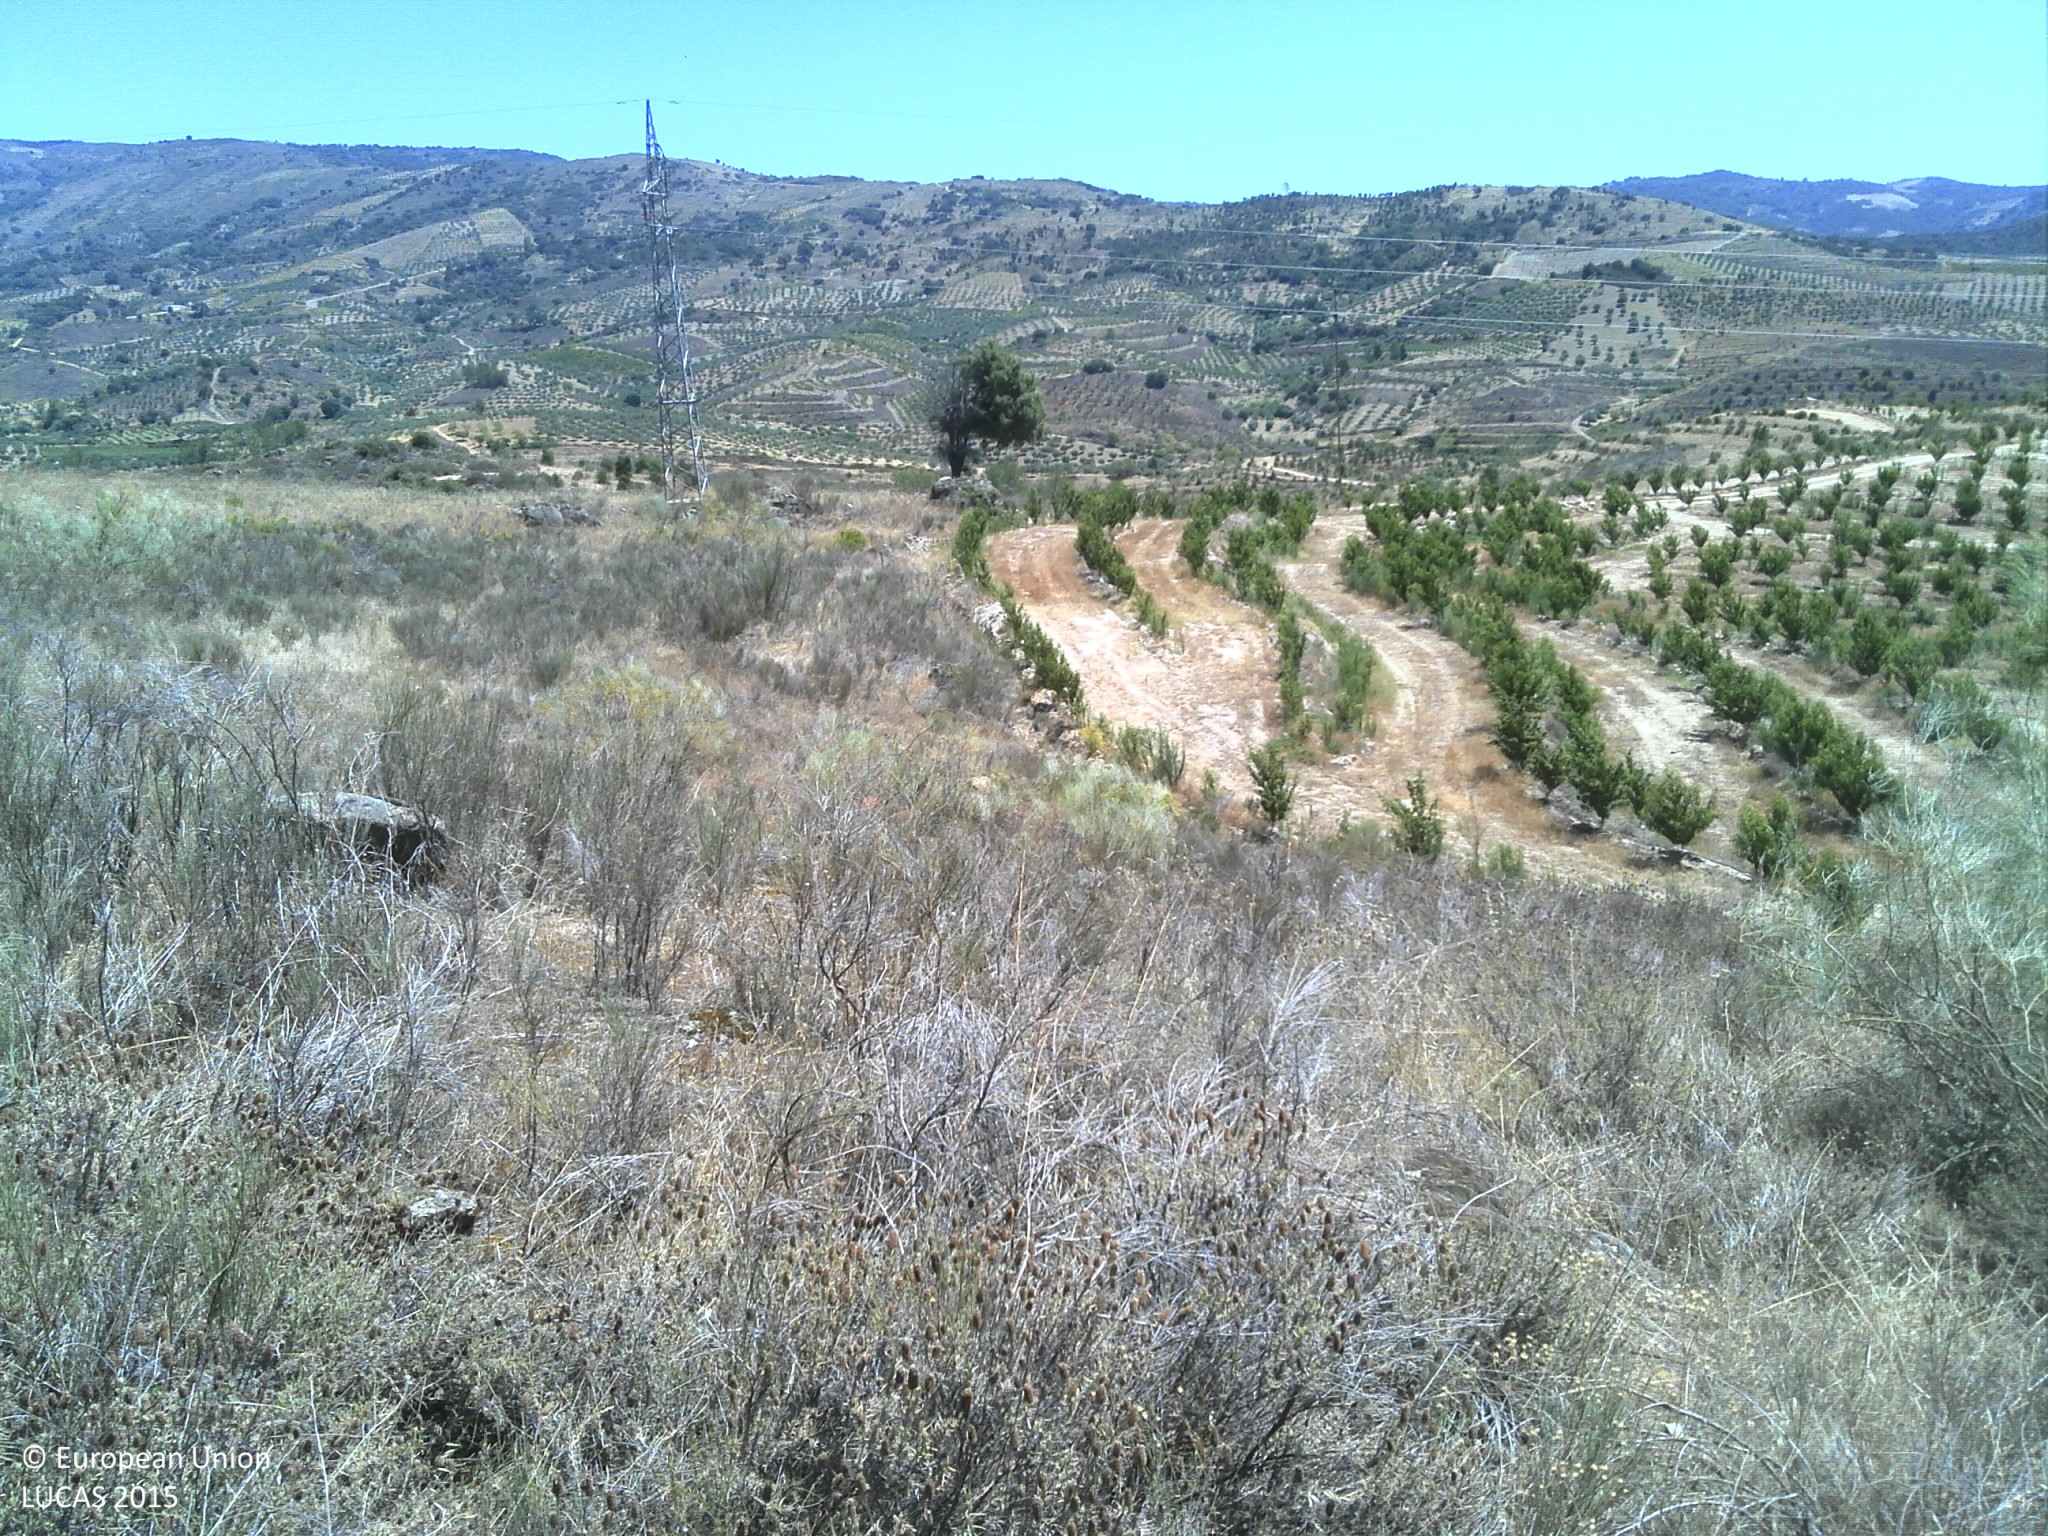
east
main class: Shrubland
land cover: Shrubland without tree cover
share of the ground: > 75 %
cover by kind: shrubs 100 %
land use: Semi-natural and natural areas not in use
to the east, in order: Shrubland without tree cover; Ditches and canals; Other fruit trees and berries; Ditches and canals; Grassland without tree/shrub cover; Electric lines; Grassland without tree/shrub cover; Rocks and stones; Grassland without tree/shrub cover; Single bushes/trees; Grassland without tree/shrub cover; Tracks; Shrubland without tree cover; Electric lines; Shrubland without tree cover; Rocks and stones; Shrubland without tree cover; Tracks; Shrubland without tree cover; Tracks; Shrubland with sparse tree cover; Broadleaved woodland
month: July
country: PT
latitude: 41.3787
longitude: -7.0575
